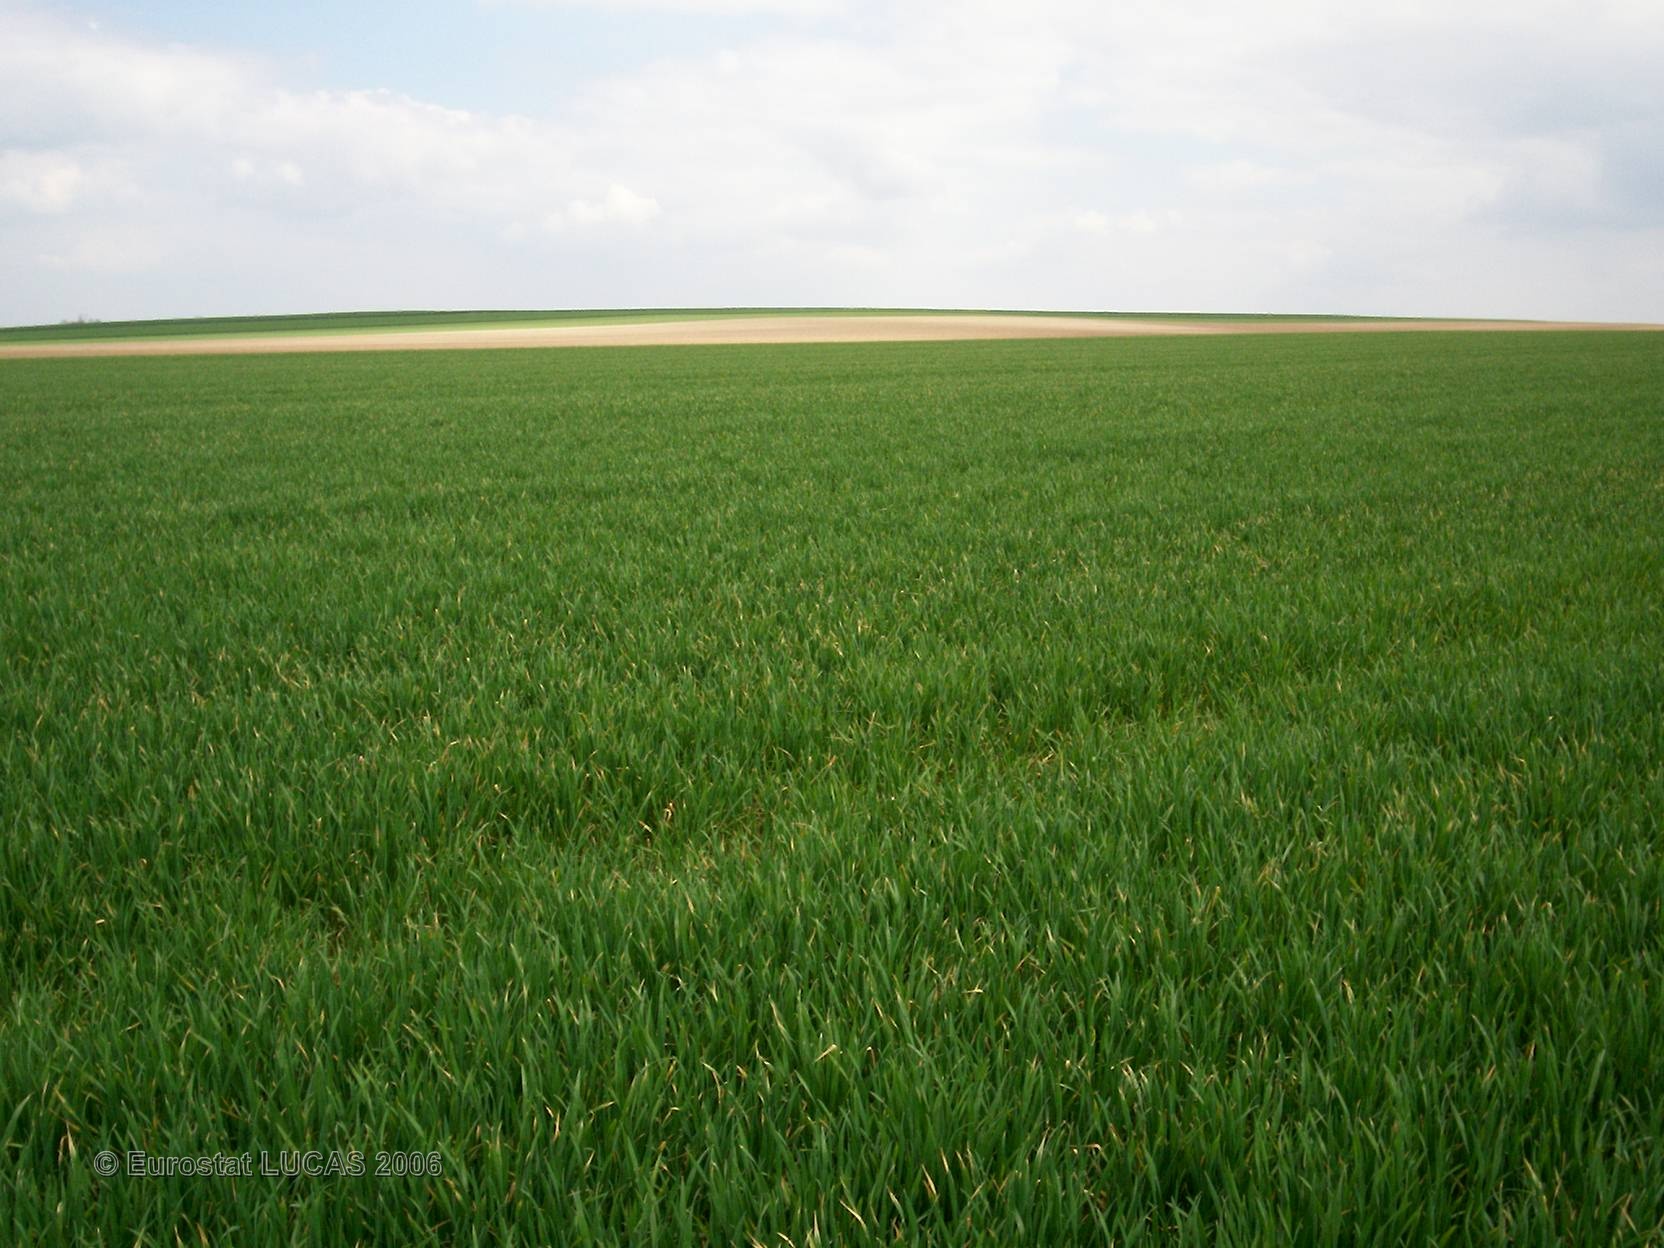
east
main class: Cropland
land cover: Common wheat
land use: Agriculture (excluding fallow land and kitchen gardens)
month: April
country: FR
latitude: 48.5005
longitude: 4.4889
